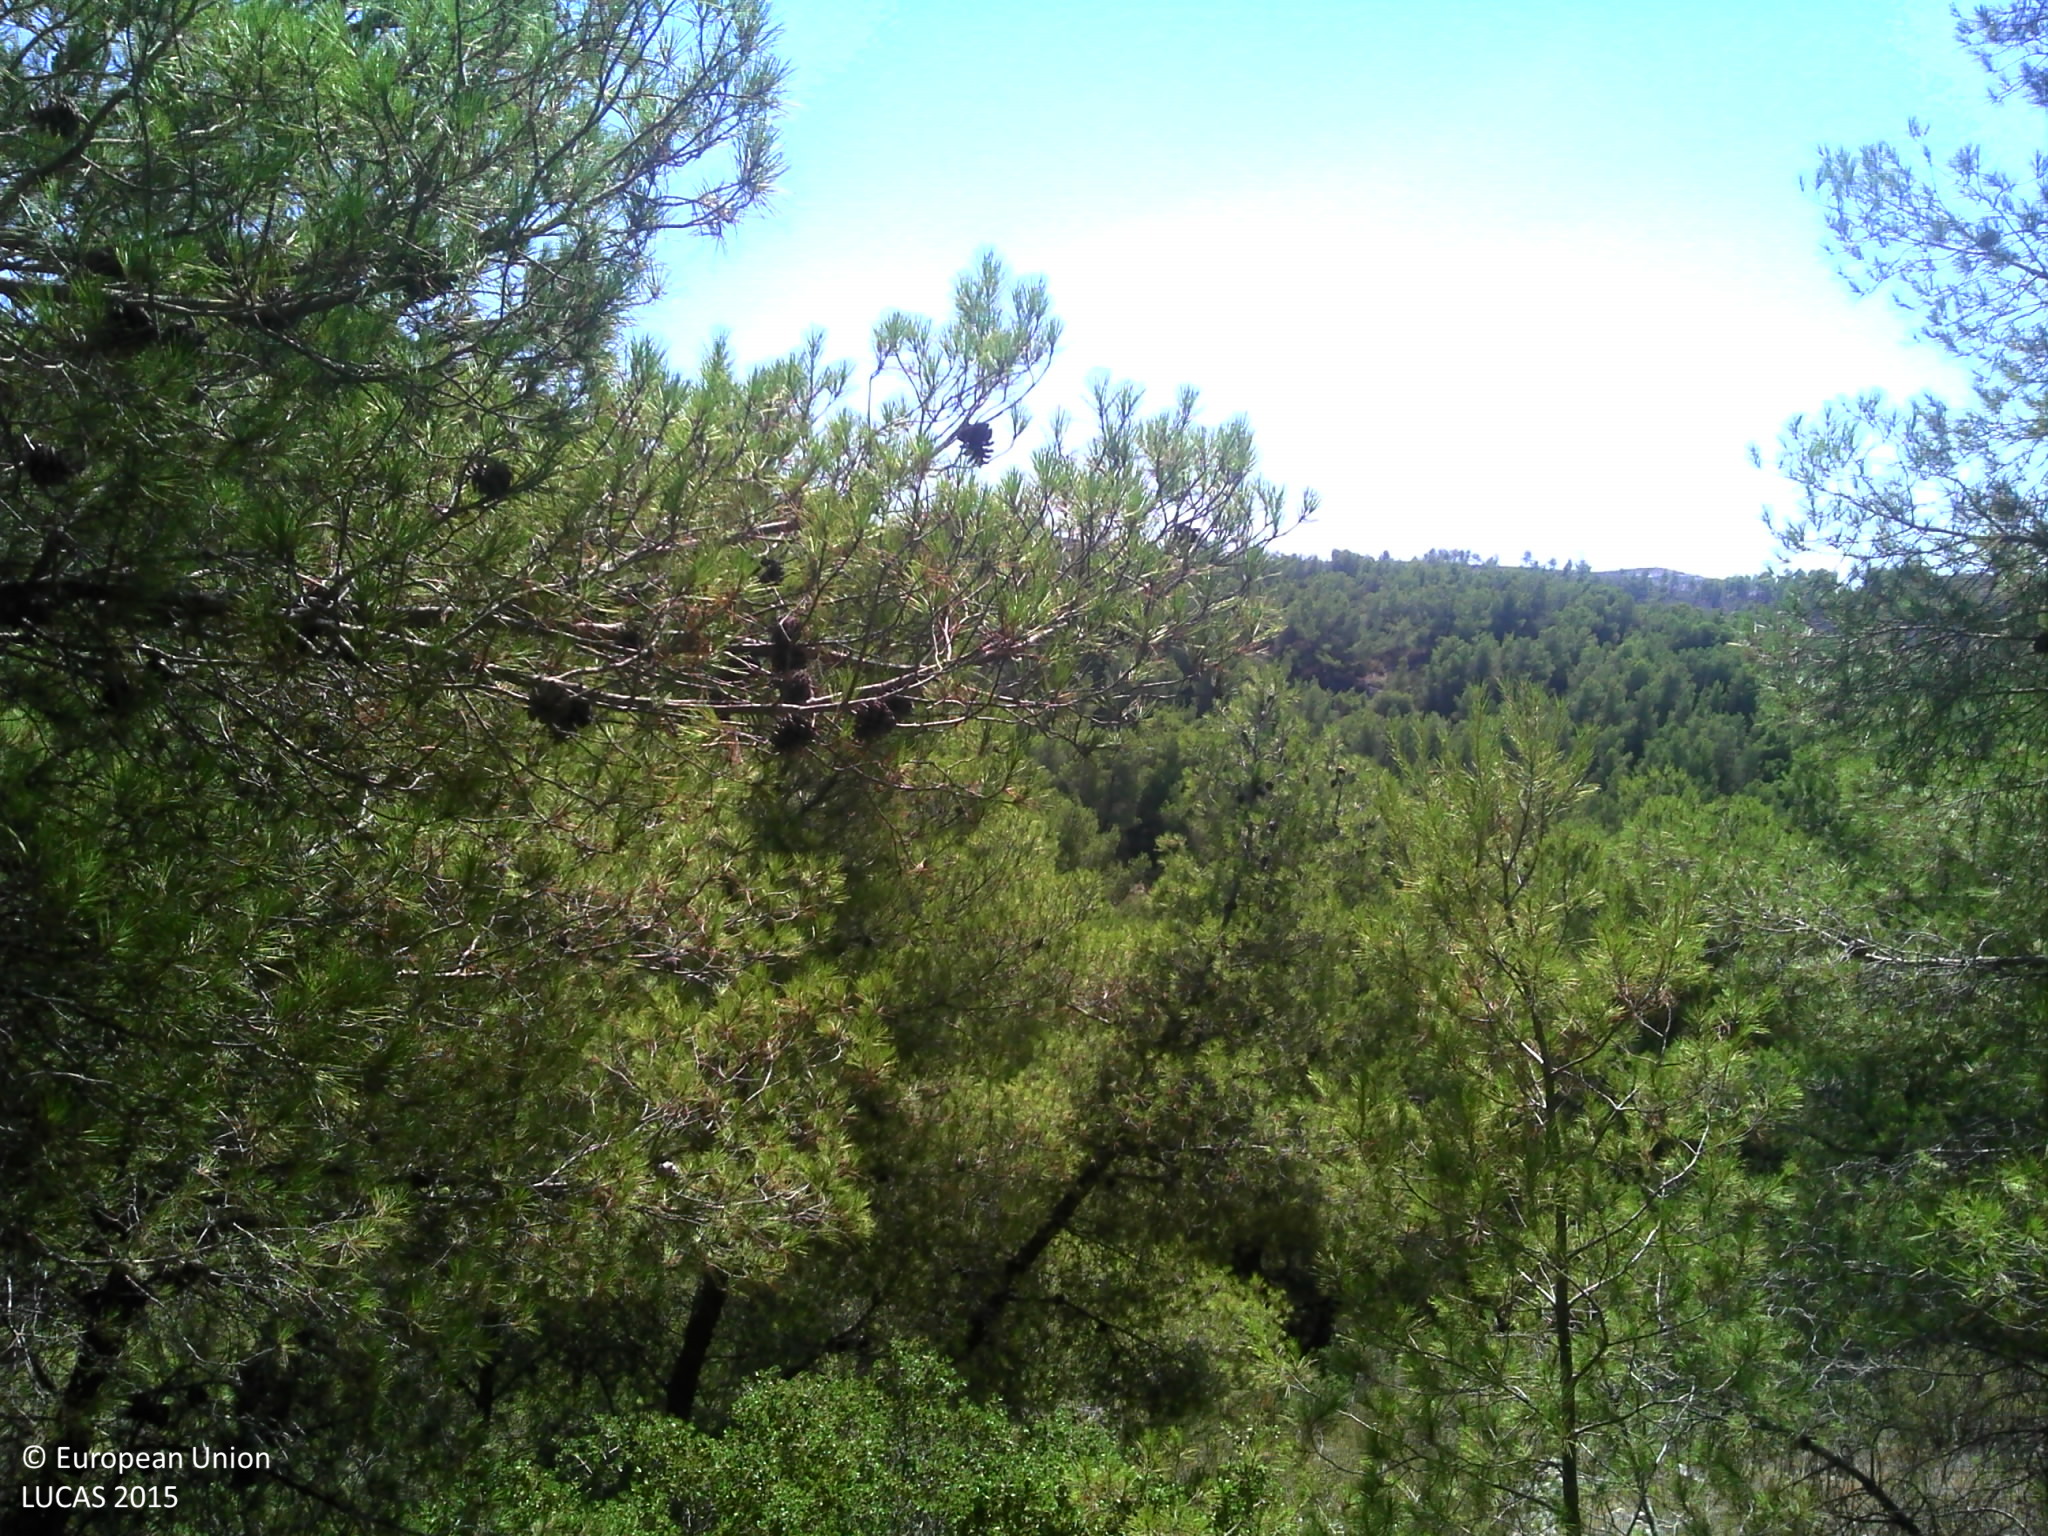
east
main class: Woodland
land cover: Pine dominated coniferous woodland
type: coniferous forest of the mediterranean region
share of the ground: > 75 %
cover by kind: coniferous forest trees 45 %, shrubs 25 %, consolidated bare surface 20 %, herbaceous plants 10 %
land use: Forestry
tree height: > 5 m
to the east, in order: Pine dominated coniferous woodland; Rock outcrops; Pine dominated coniferous woodland; Shrubland without tree cover; Tracks; Pine dominated coniferous woodland; Shrubland without tree cover; Rock outcrops; Pine dominated coniferous woodland; Shrubland without tree cover; Tracks; Shrubland without tree cover; Pine dominated coniferous woodland; Rocks and stones; Pine dominated coniferous woodland
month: August
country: FR
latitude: 43.3679
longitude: 5.1111
